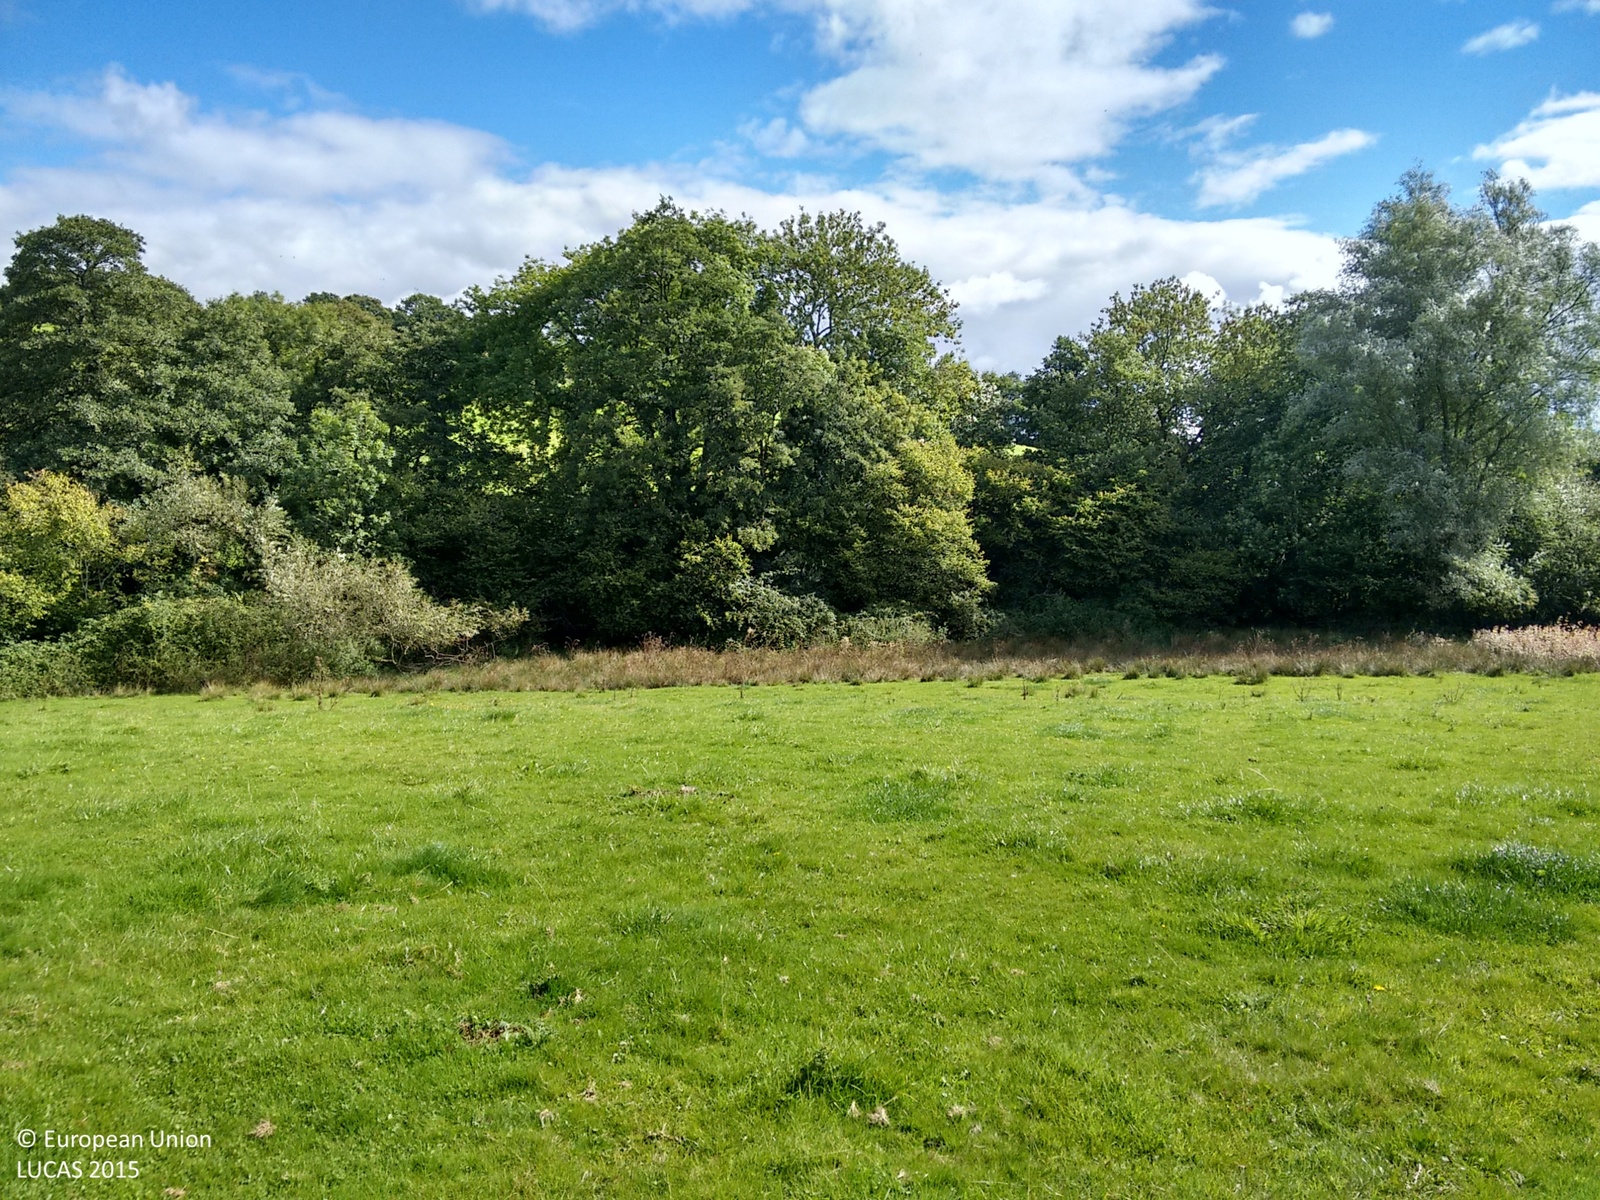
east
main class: Grassland
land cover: Grassland without tree/shrub cover
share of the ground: > 75 %
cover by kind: herbaceous plants 100 %
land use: Agriculture (excluding fallow land and kitchen gardens)
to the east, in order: Grassland without tree/shrub cover; Broadleaved woodland; Fences; Rivers and streams; Broadleaved woodland; Grassland without tree/shrub cover; Fences; Tracks; Grassland without tree/shrub cover; Managed hedges; Grassland without tree/shrub cover
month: September
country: GB
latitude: 51.6428
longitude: -2.9793
